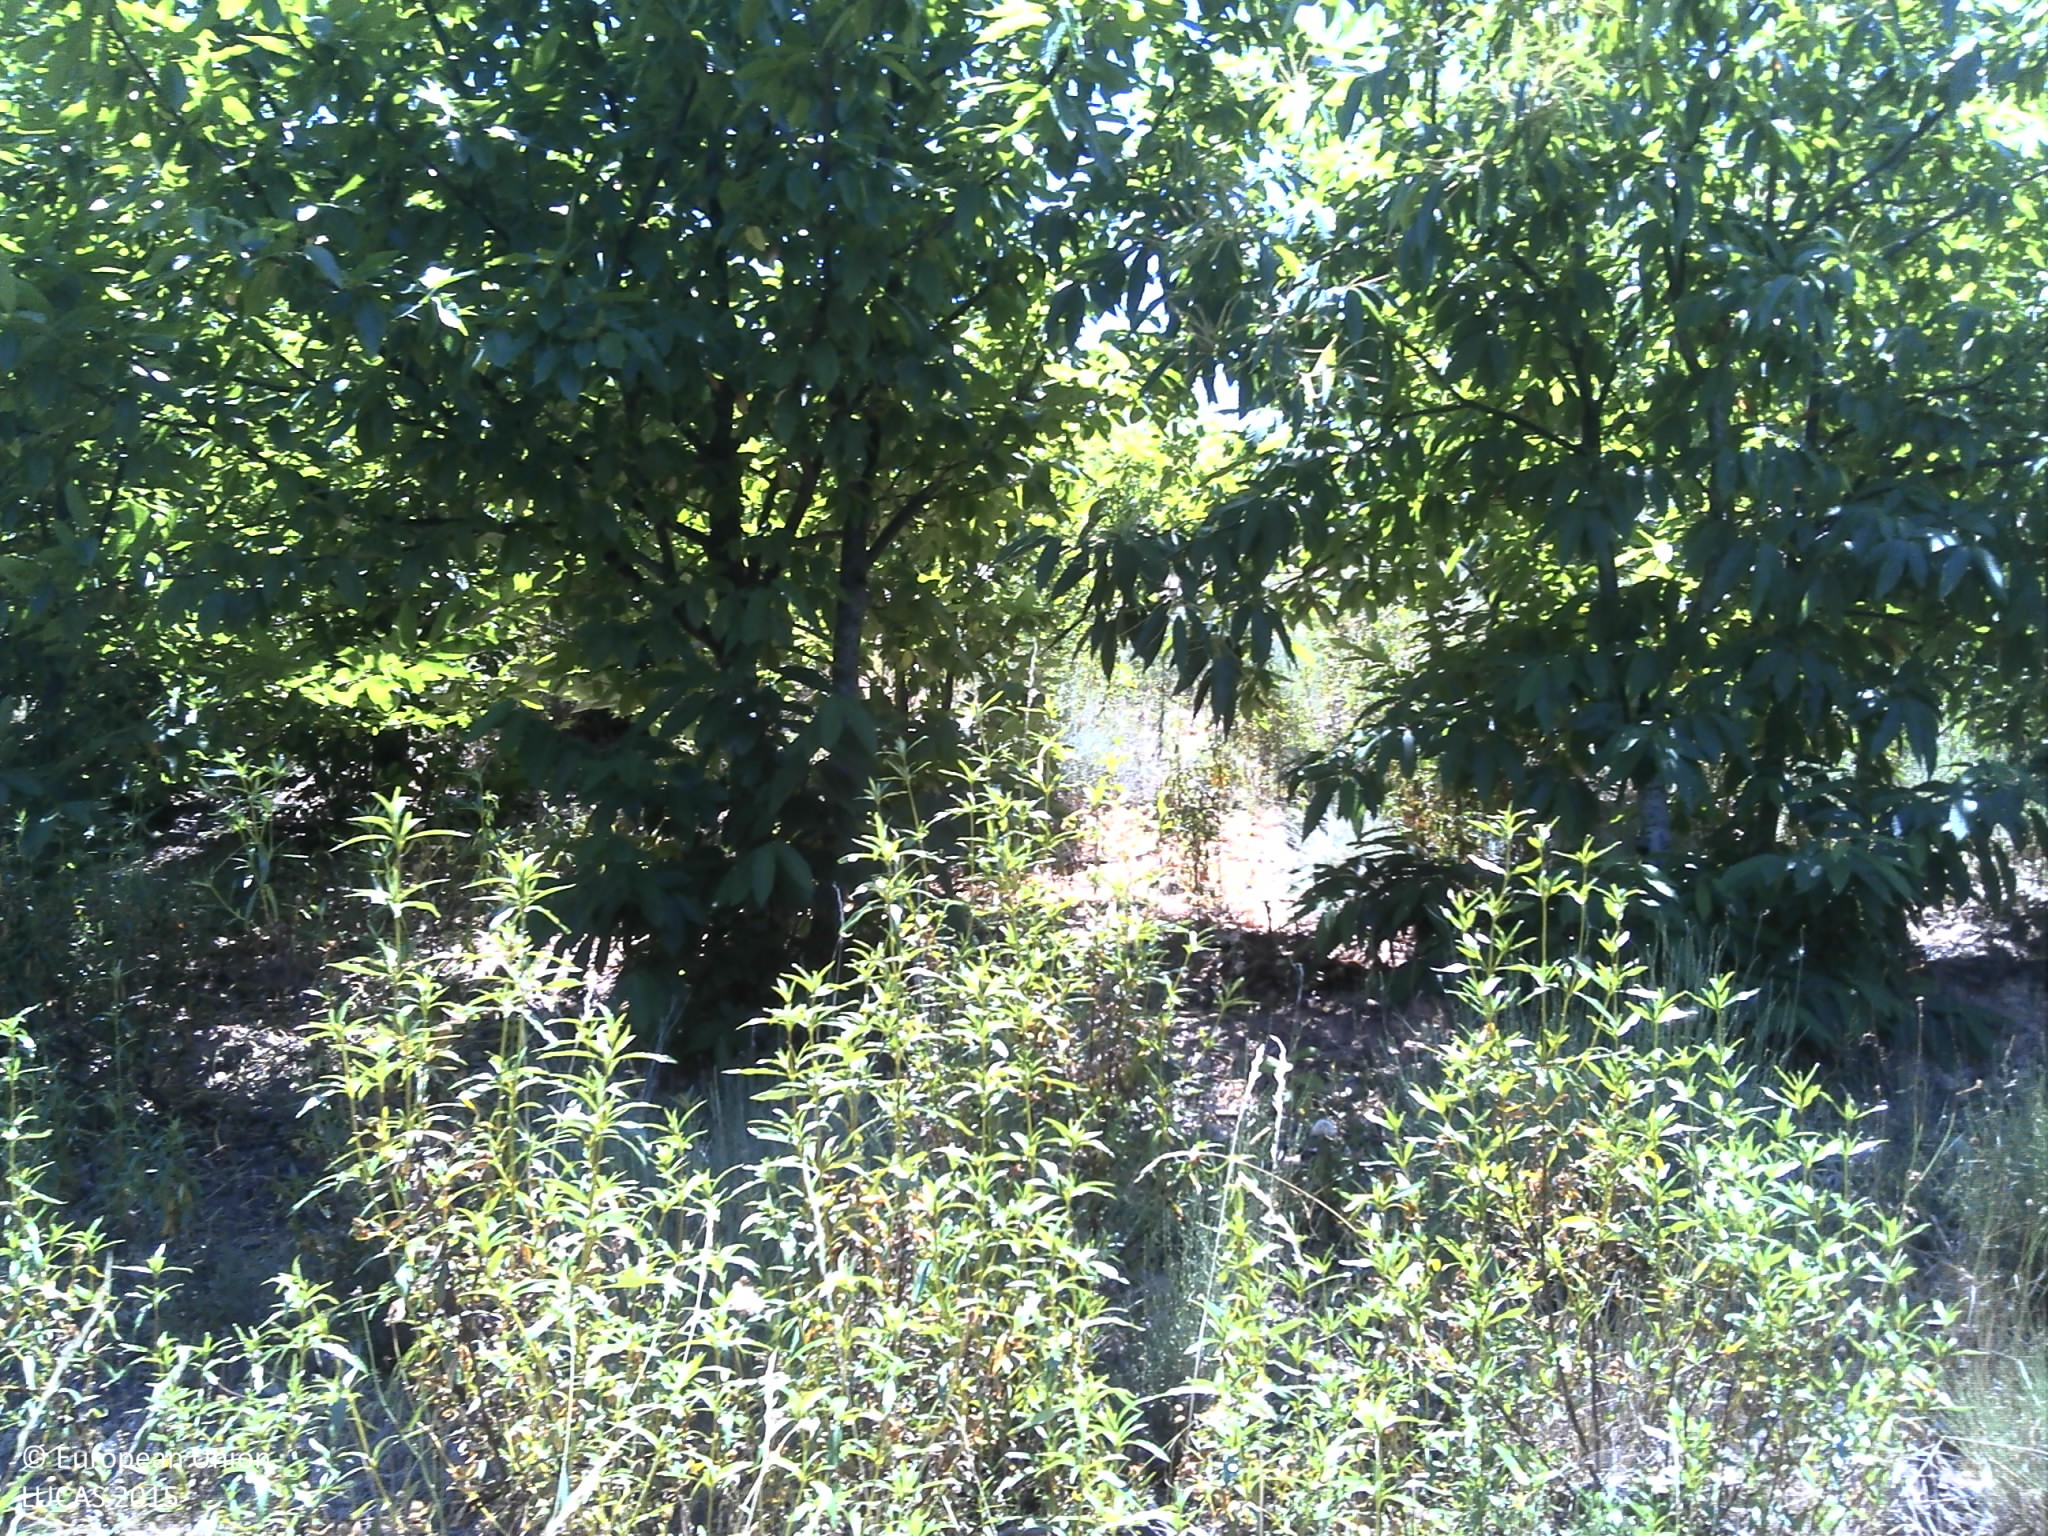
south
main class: Woodland
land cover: Broadleaved woodland
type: thermophilous deciduous forest
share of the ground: 10 - 25 %
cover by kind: shrubs 80 %, broadleaved forest trees 20 %
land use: Forestry
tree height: < 5 m
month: June
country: PT
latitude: 41.0489
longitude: -6.9409
